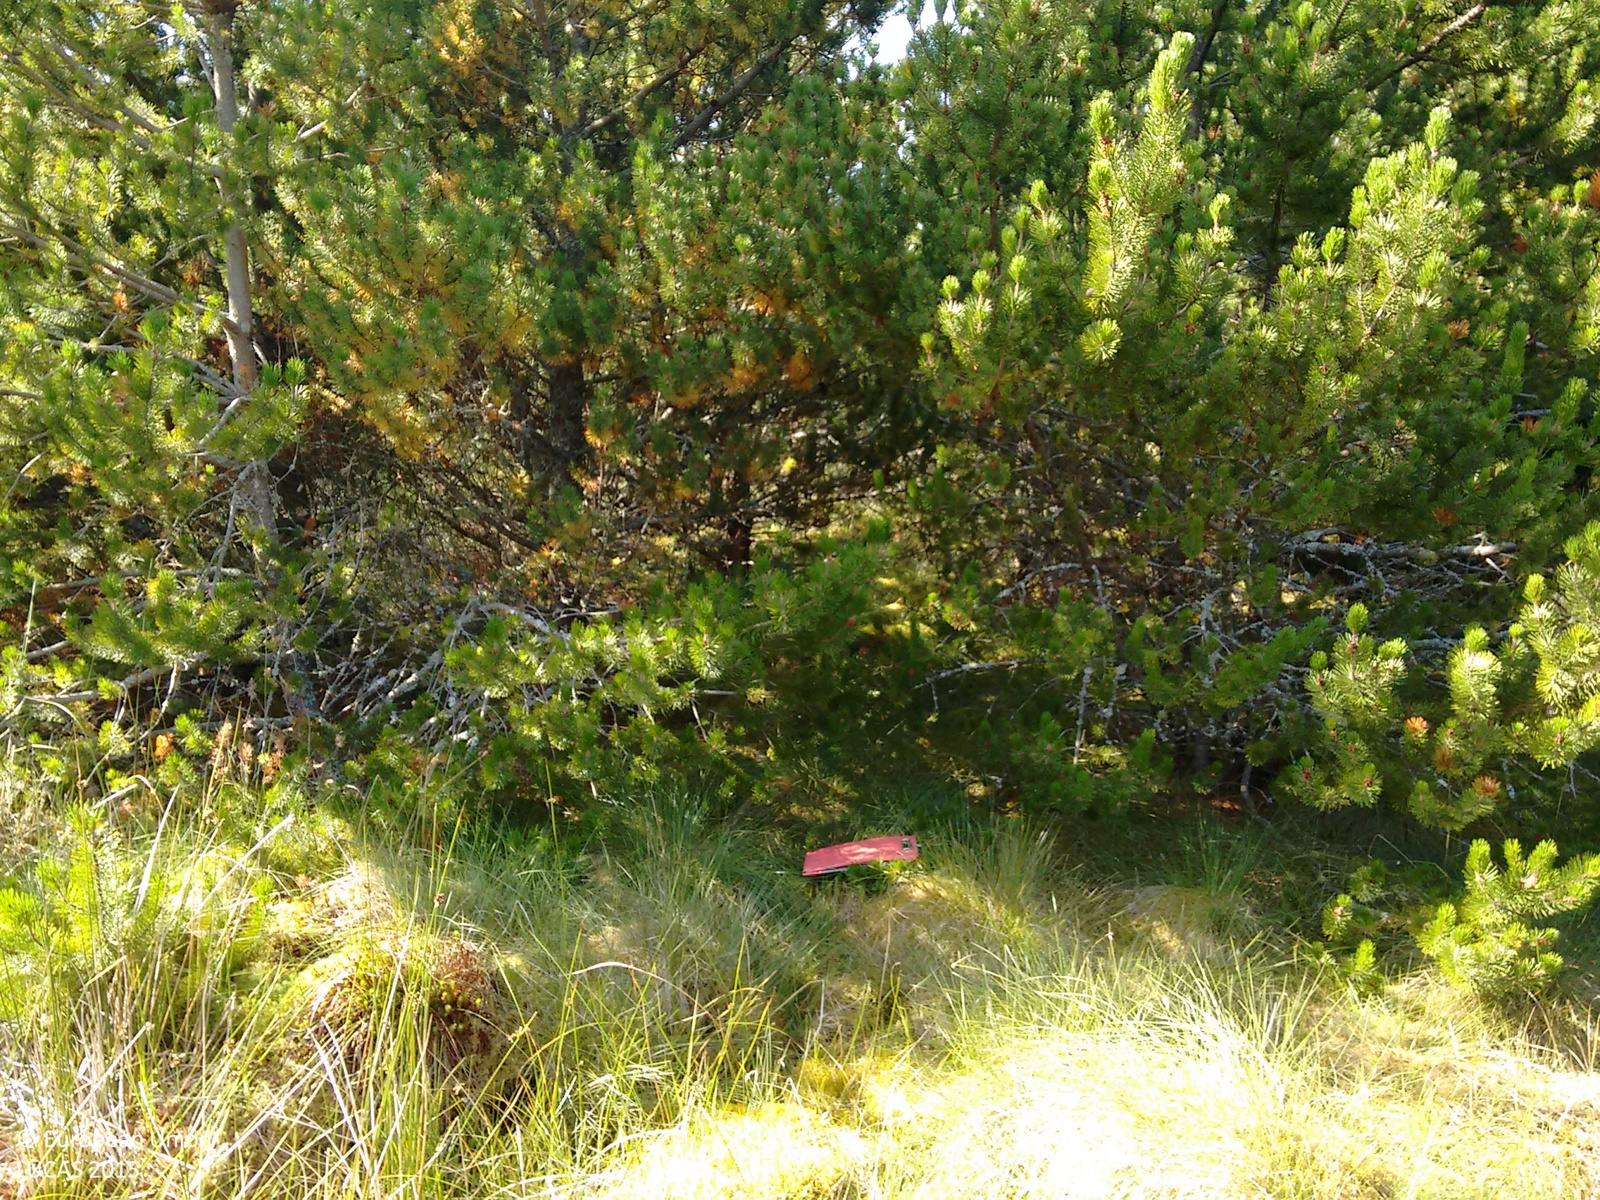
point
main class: Woodland
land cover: Pine dominated mixed woodland
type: exotic forest
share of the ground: > 75 %
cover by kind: coniferous forest trees 45 %, herbaceous plants 30 %, broadleaved forest trees 15 %, lichens and mosses 10 %
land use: Forestry
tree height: > 5 m
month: September
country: GB
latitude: 58.0779
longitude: -4.4137
